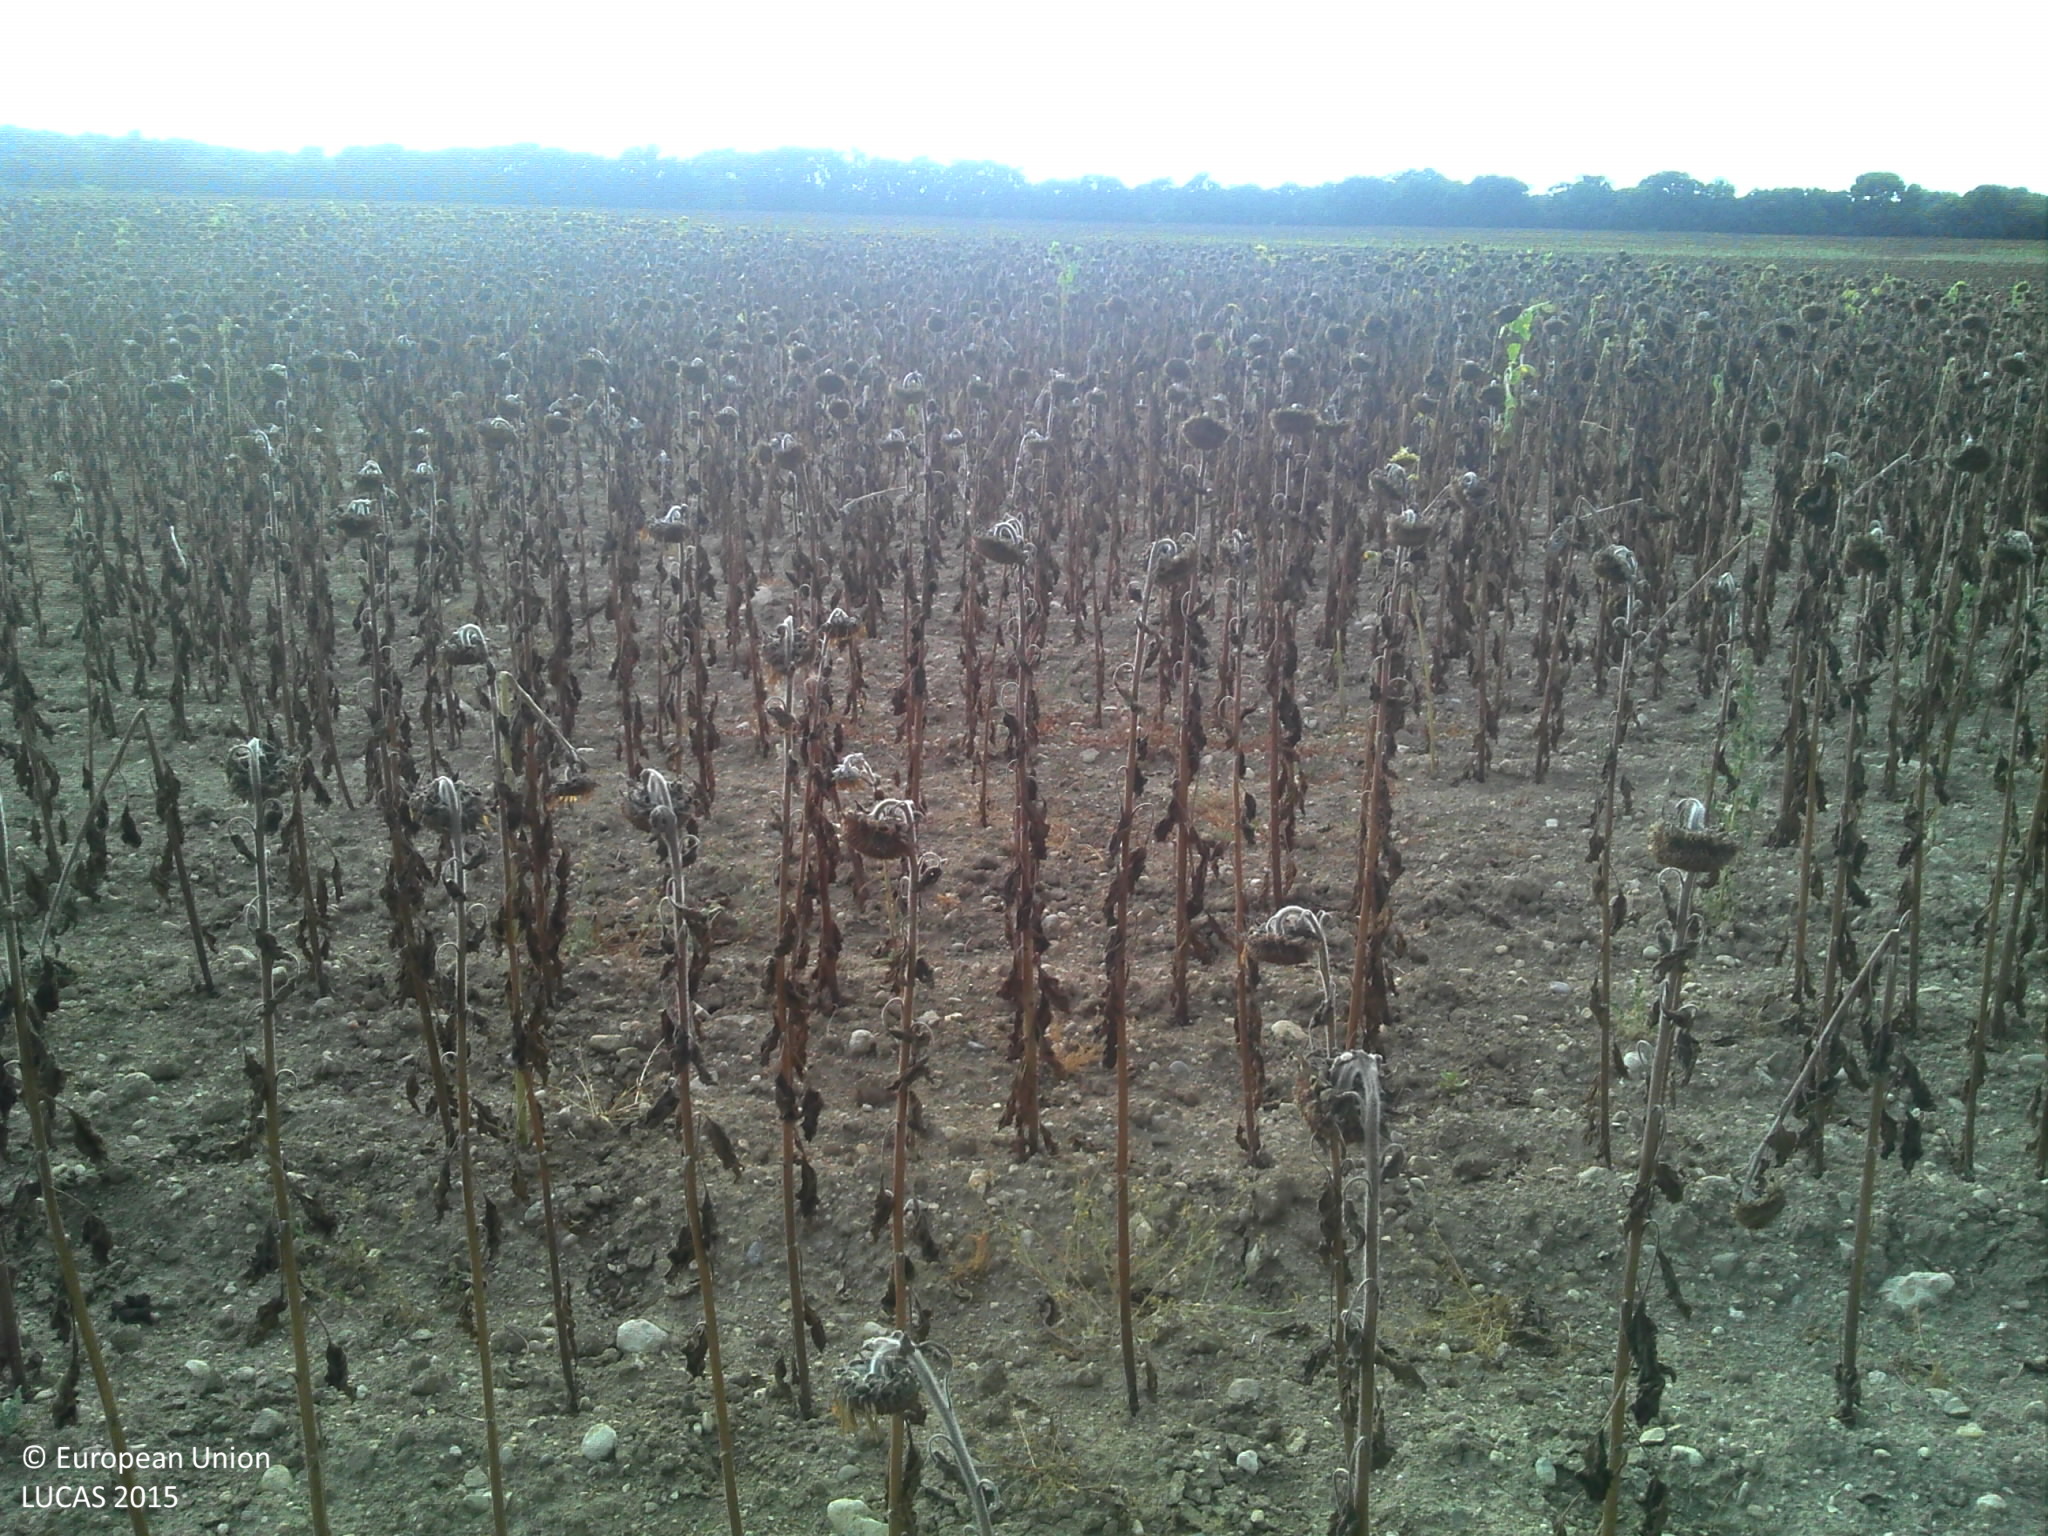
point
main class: Cropland
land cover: Sunflower
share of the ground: 25 - 50 %
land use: Agriculture (excluding fallow land and kitchen gardens)
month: August
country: FR
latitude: 43.5977
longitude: 5.3890
